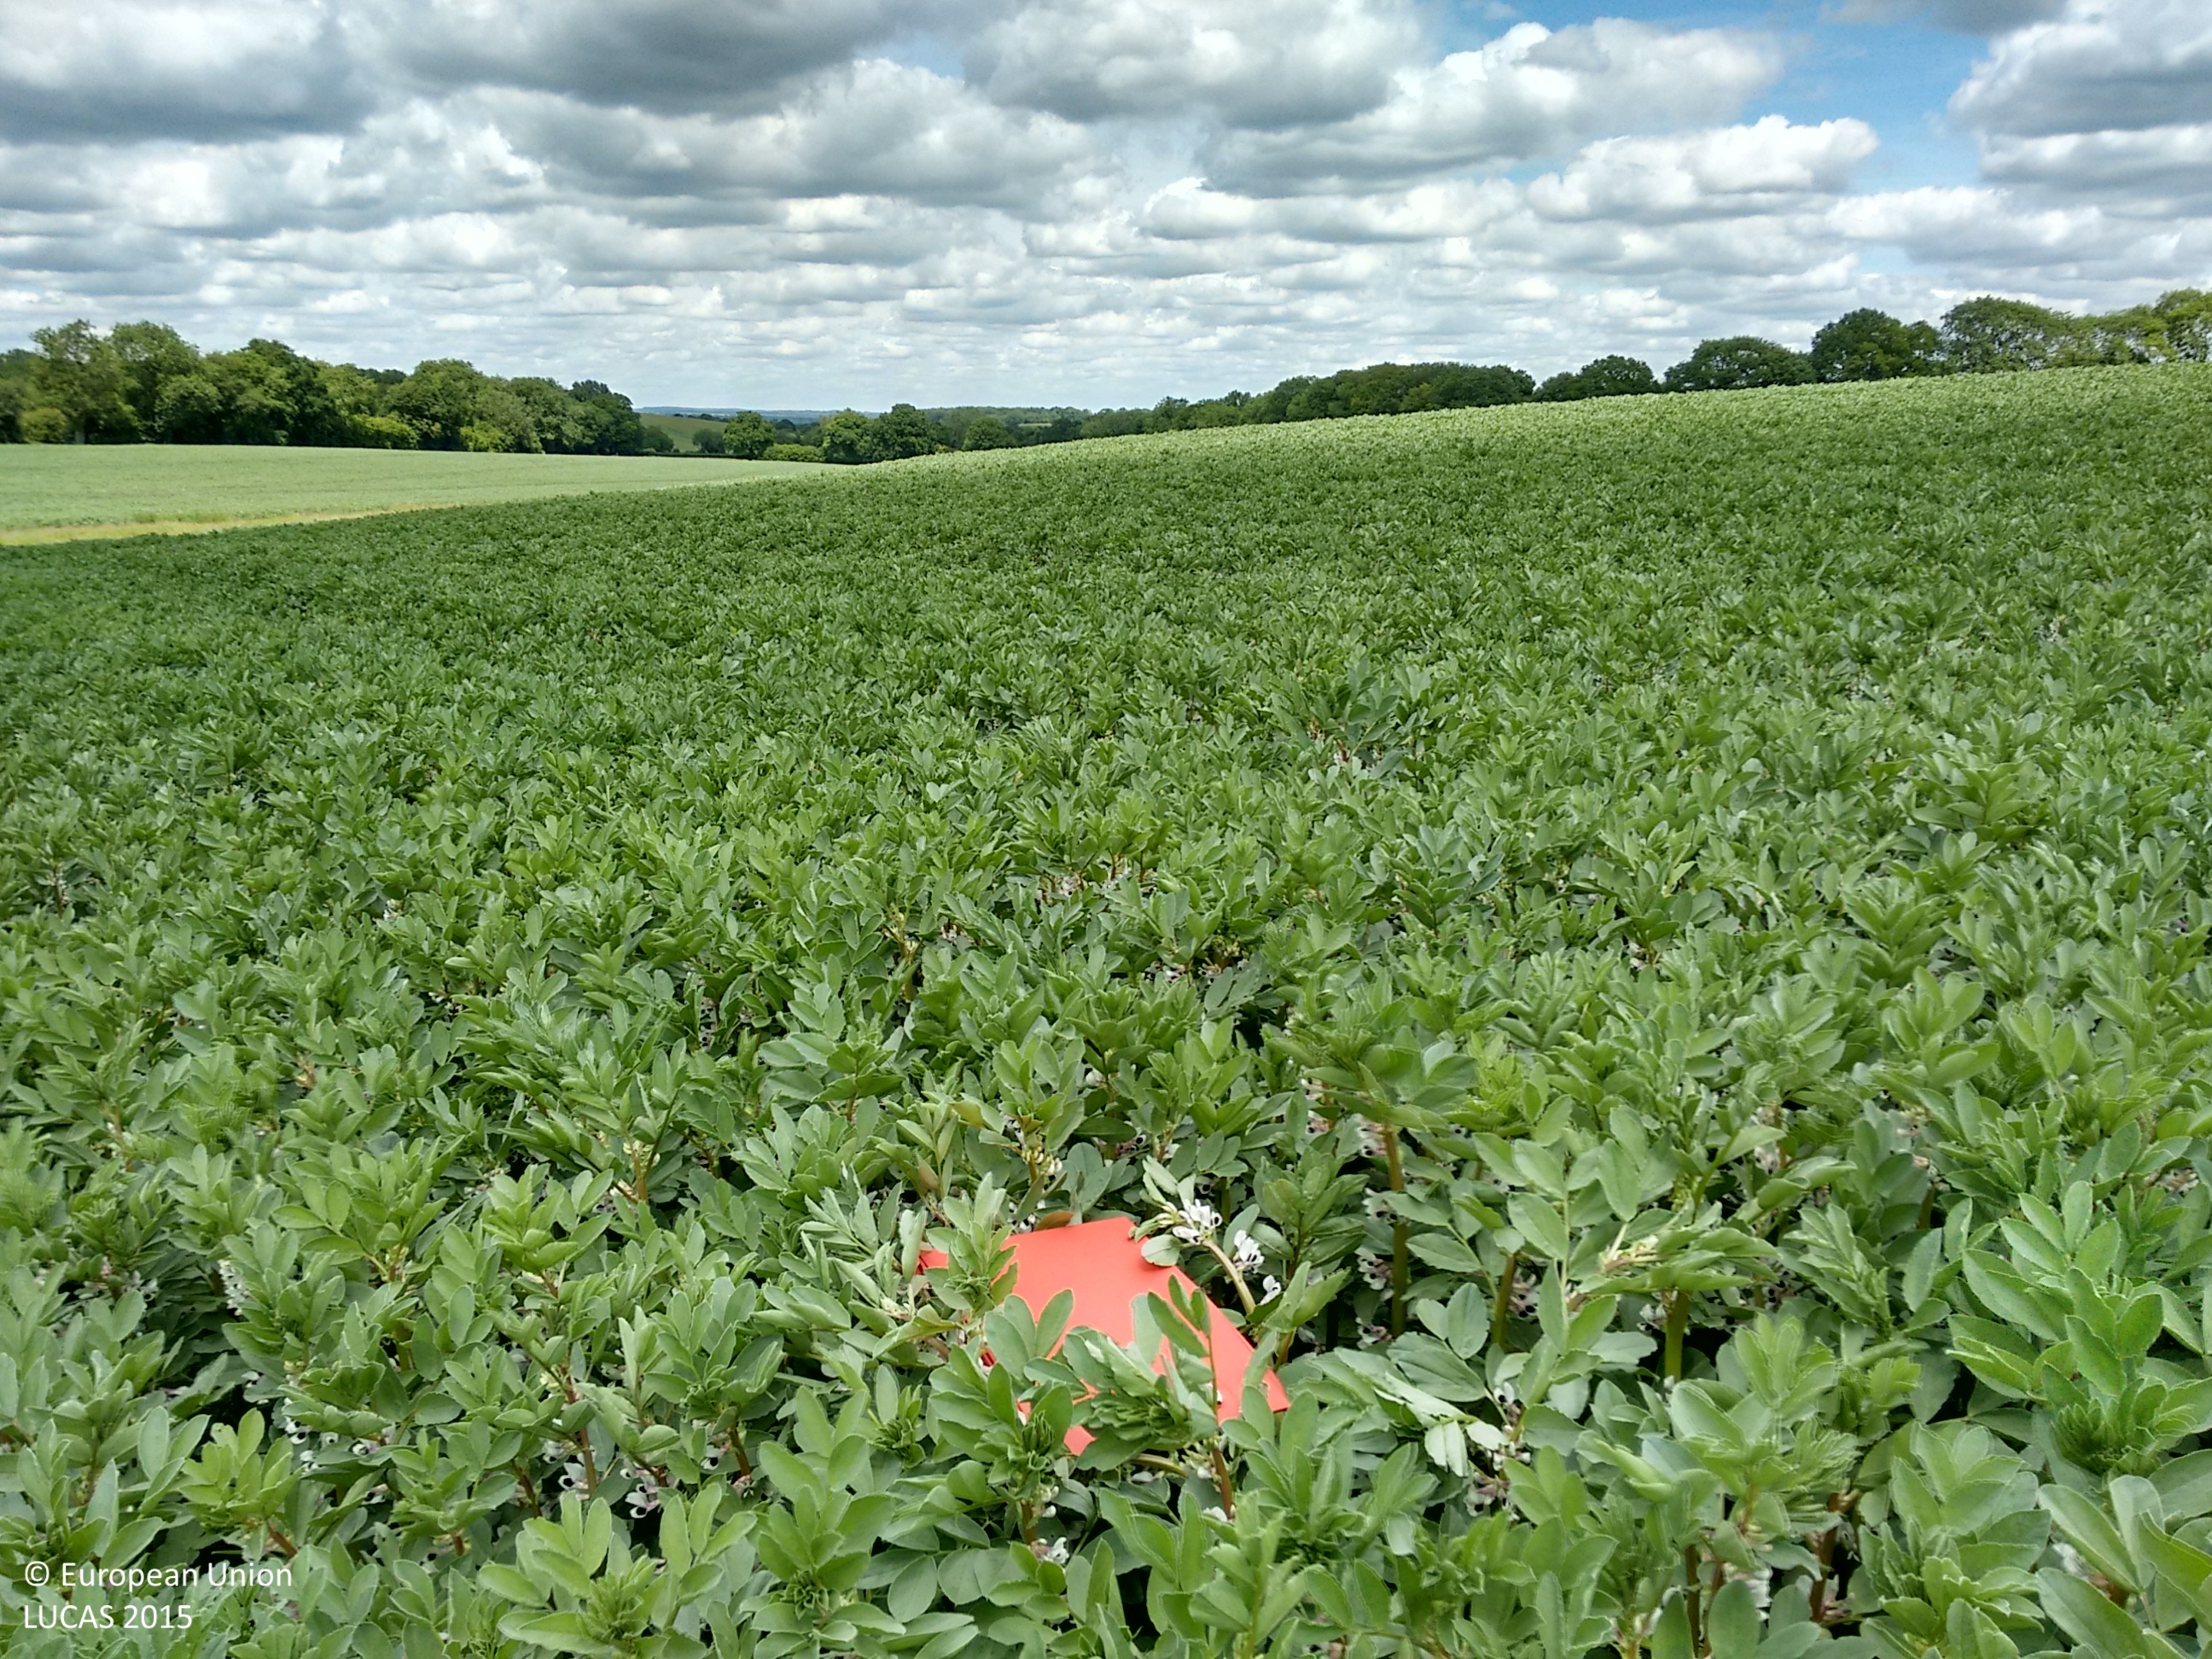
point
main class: Cropland
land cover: Dry pulses
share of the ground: > 75 %
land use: Agriculture (excluding fallow land and kitchen gardens)
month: June
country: GB
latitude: 51.3625
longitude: -1.4978
